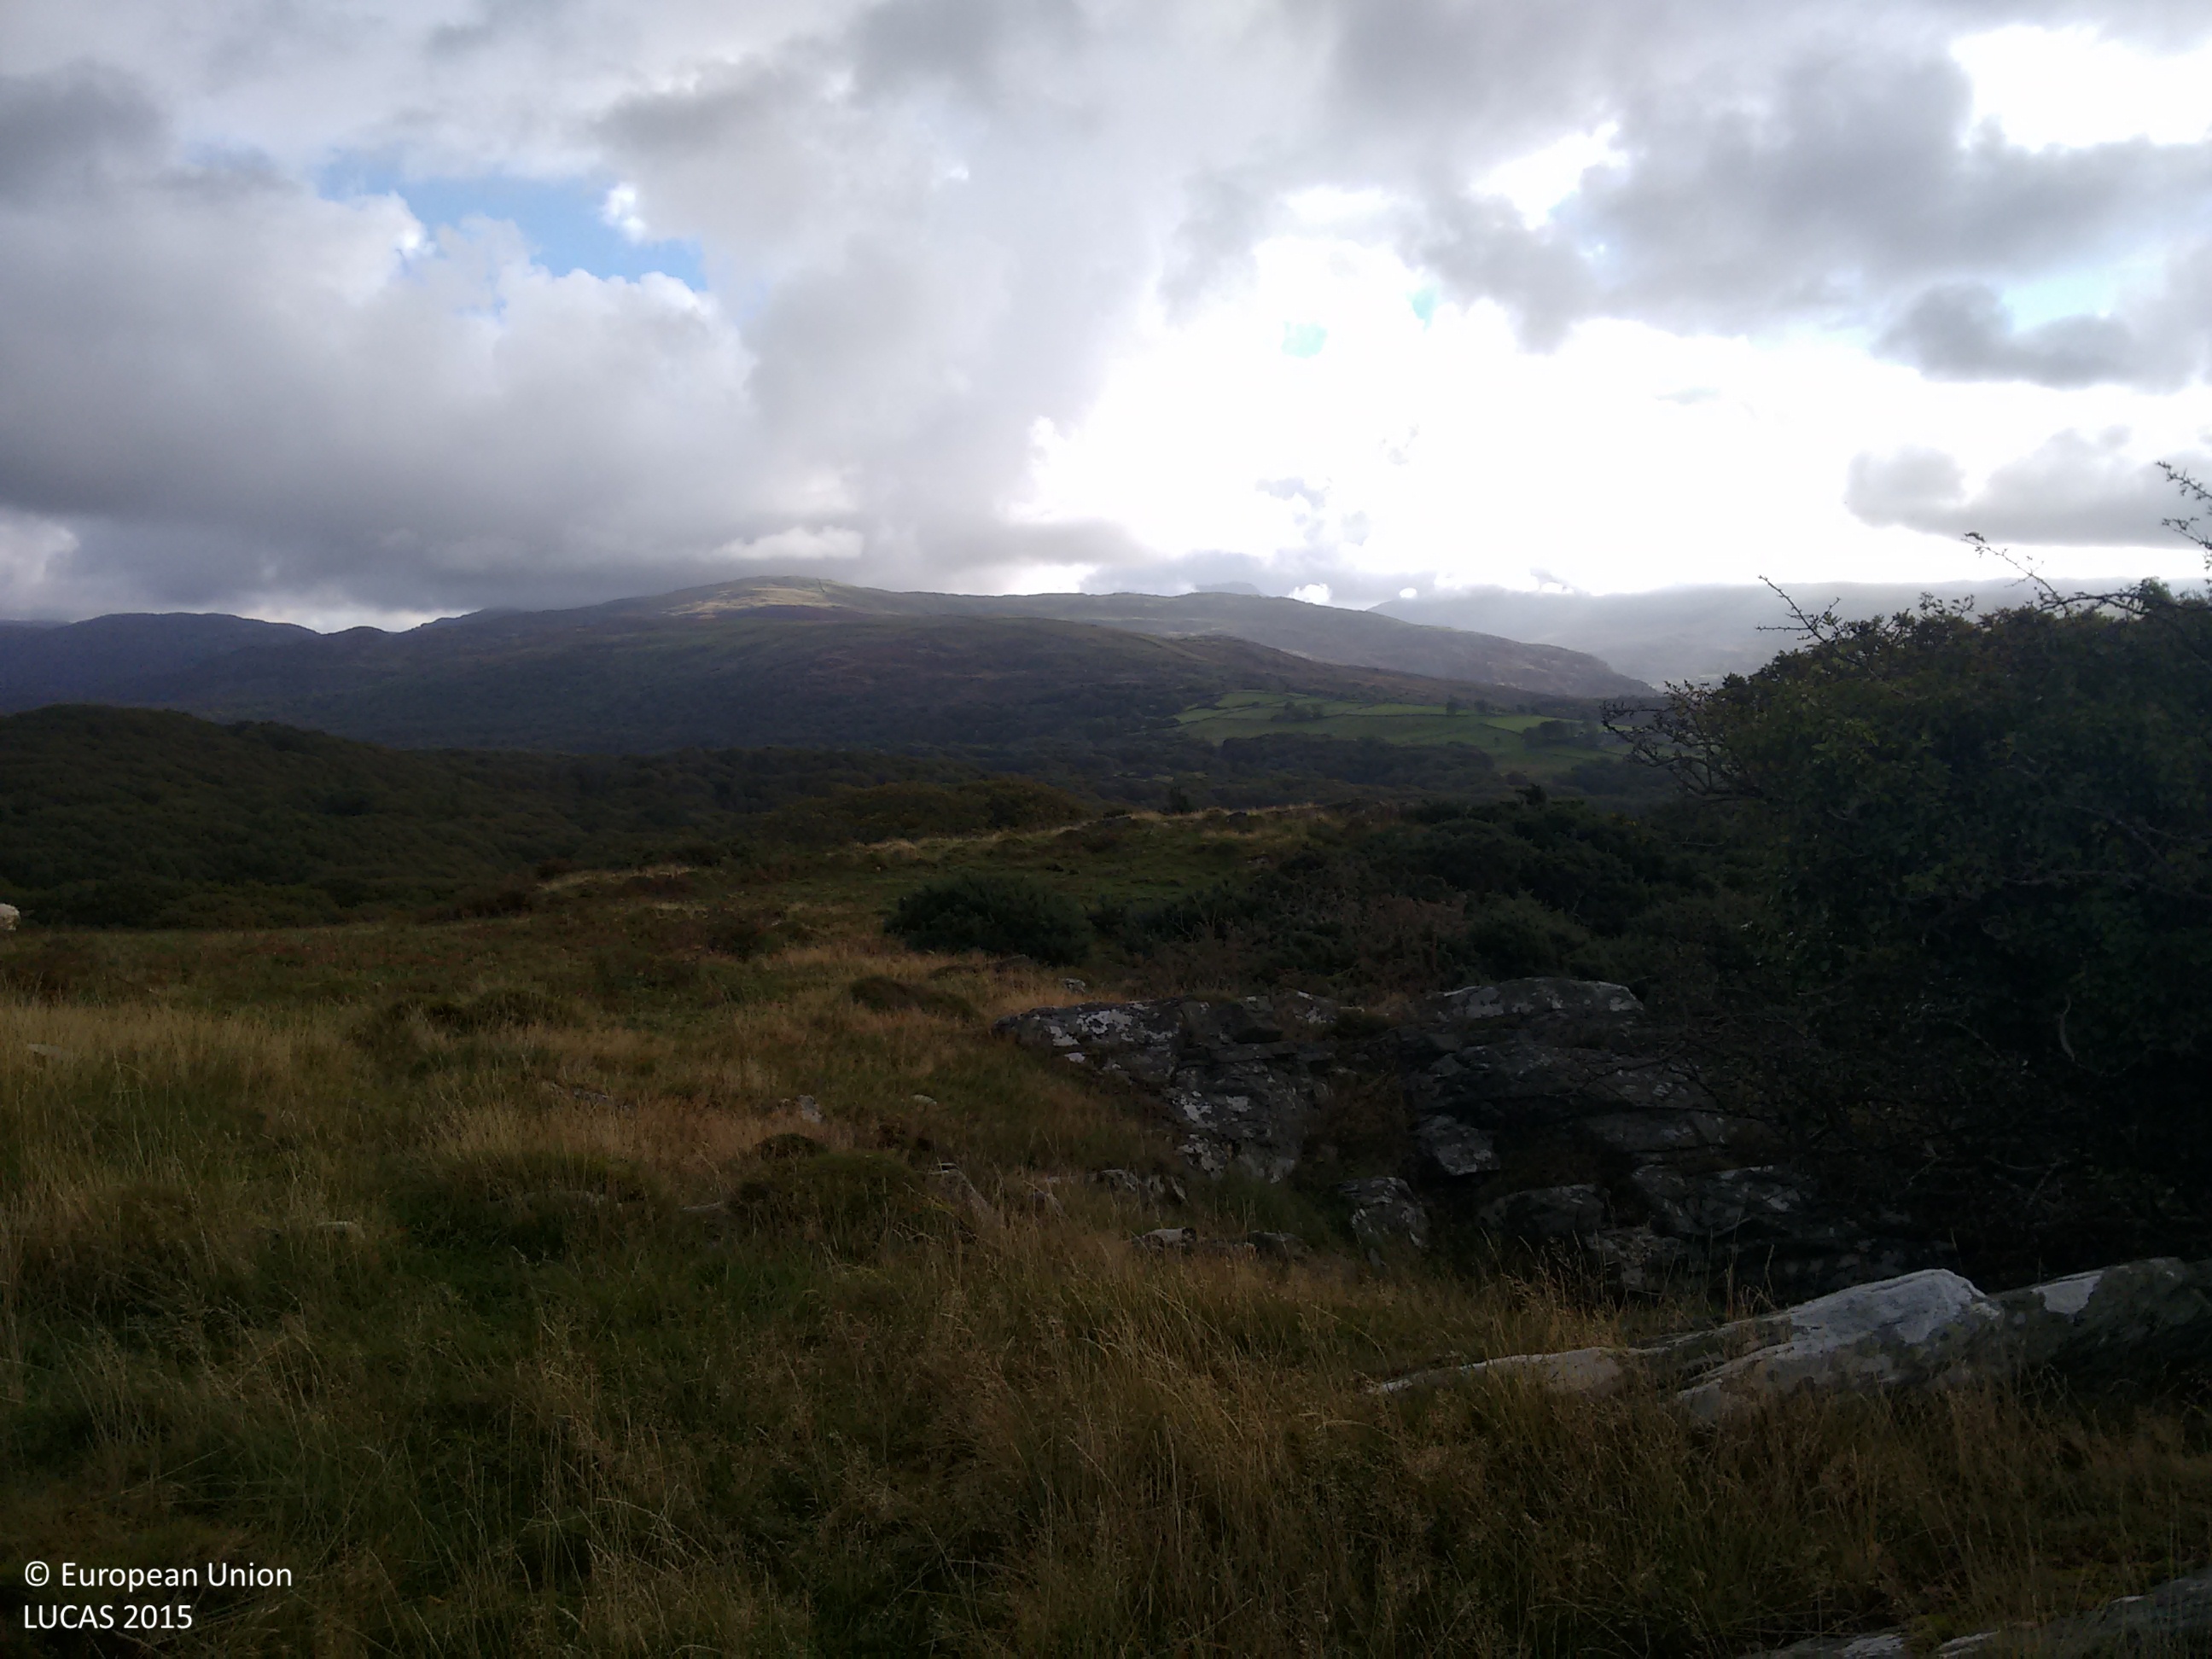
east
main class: Woodland
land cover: Broadleaved woodland
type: mesophytic deciduous forest
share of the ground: > 75 %
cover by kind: broadleaved forest trees 100 %
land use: Semi-natural and natural areas not in use
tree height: > 5 m
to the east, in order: Broadleaved woodland; Shrubland with sparse tree cover; Grassland without tree/shrub cover; Shrubland with sparse tree cover; Broadleaved woodland; Grassland without tree/shrub cover; Electric lines; Tracks; Grassland without tree/shrub cover
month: October
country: GB
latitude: 52.8279
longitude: -4.0919
